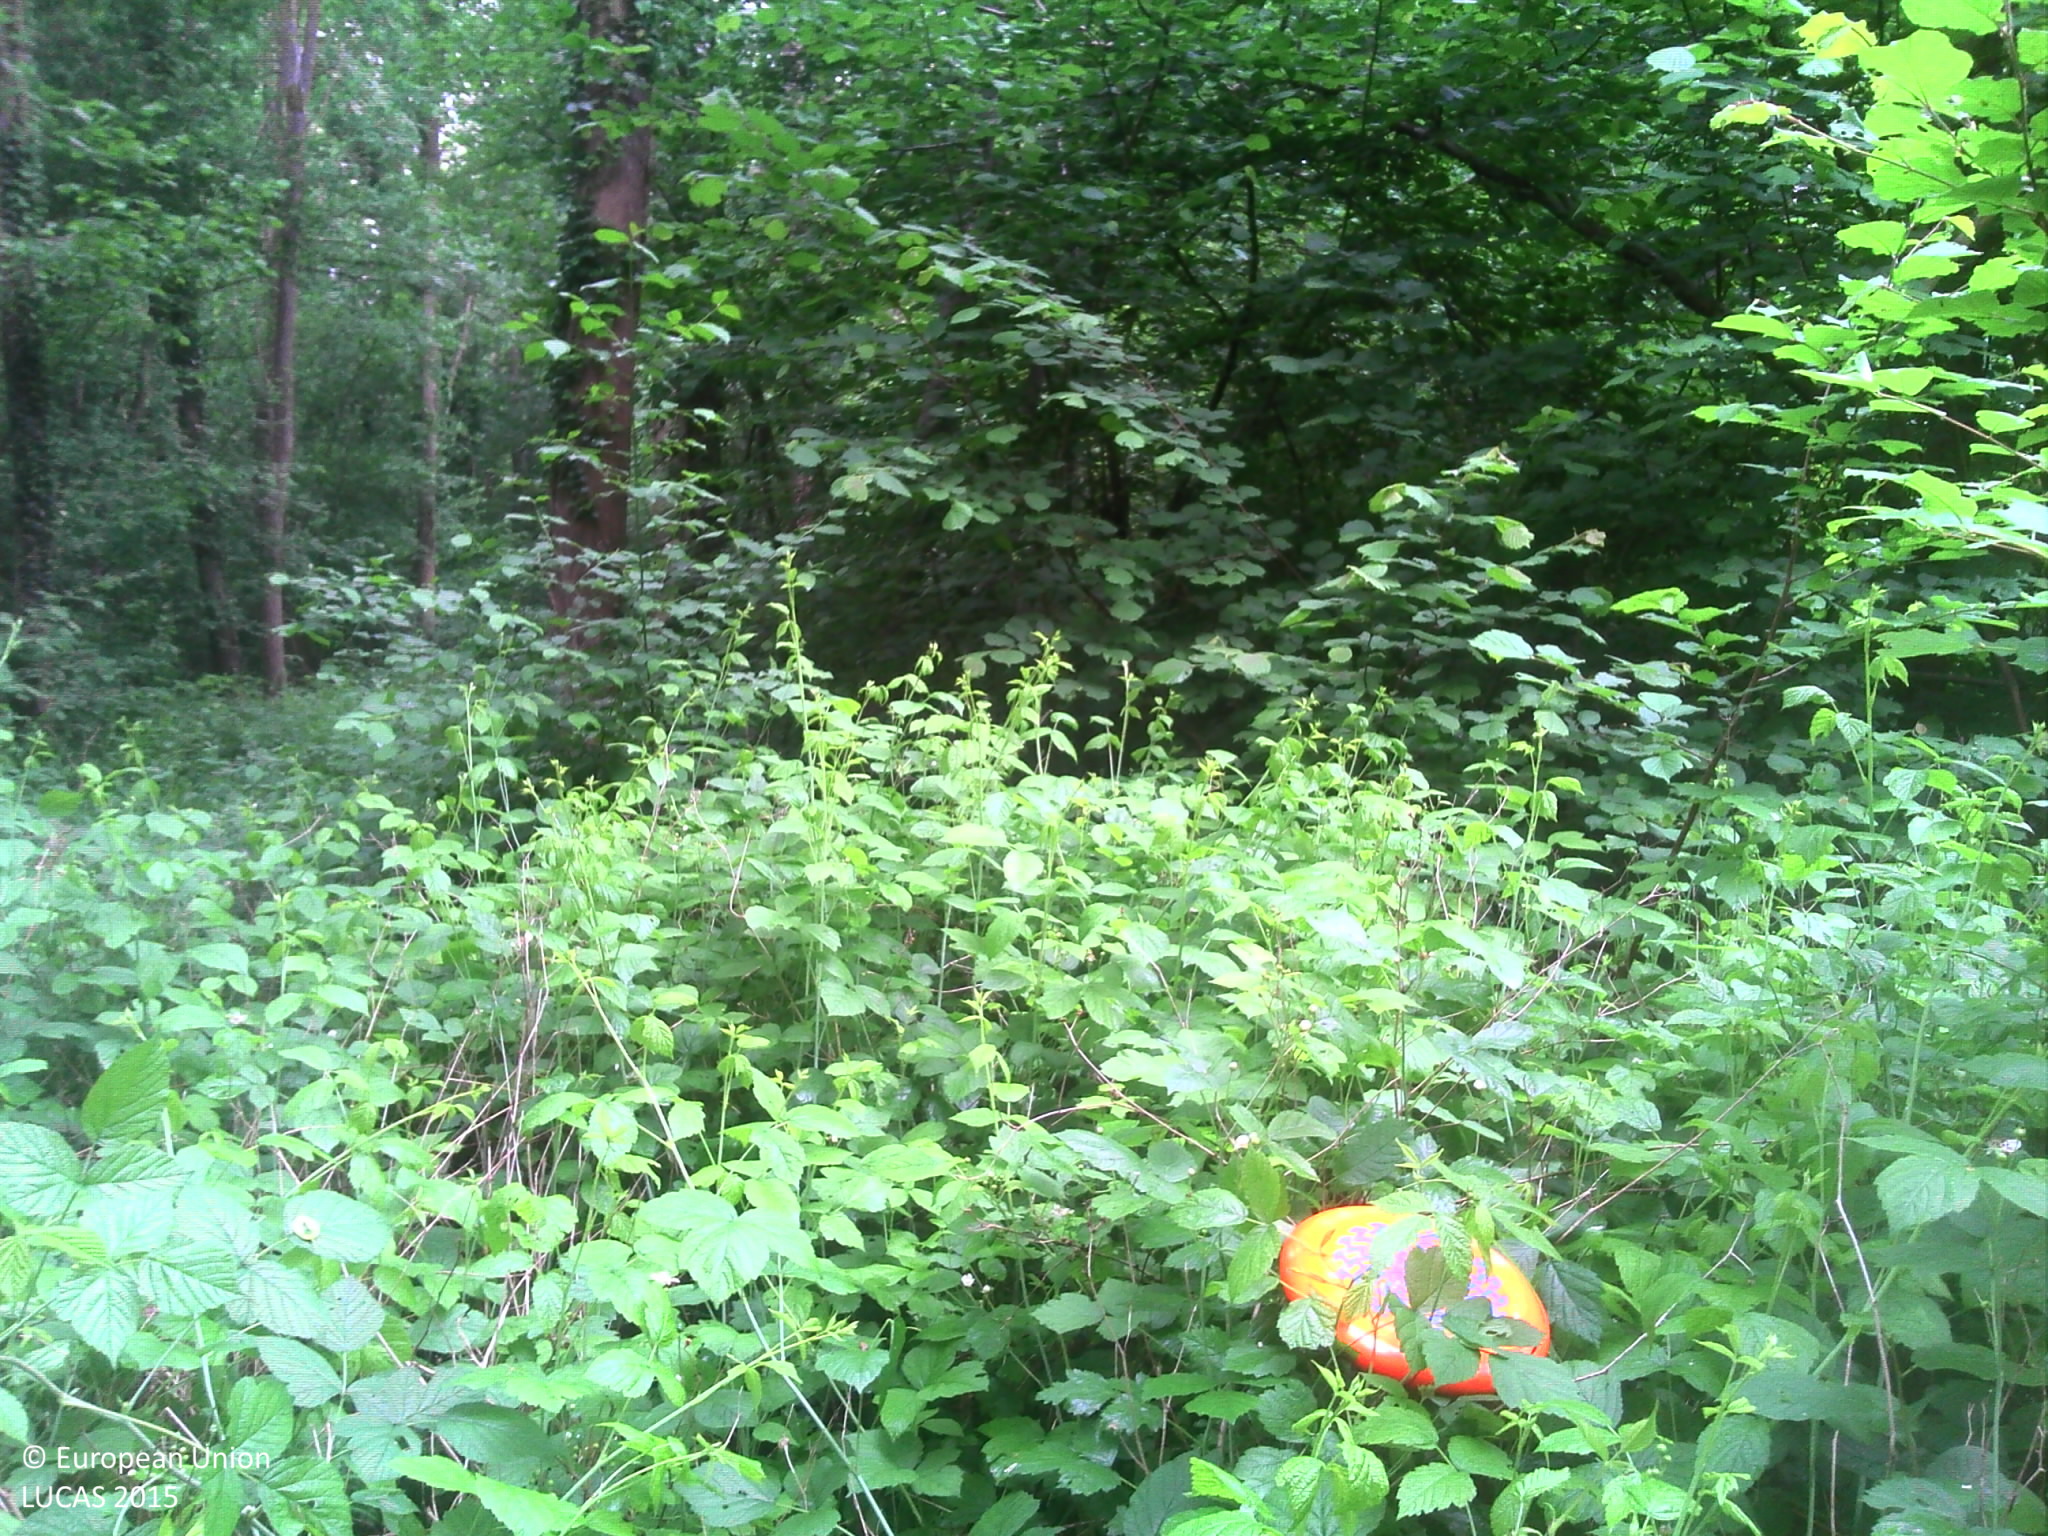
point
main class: Woodland
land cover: Broadleaved woodland
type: mesophytic deciduous forest
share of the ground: > 75 %
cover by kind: broadleaved forest trees 90 %, herbaceous plants 10 %
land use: Forestry
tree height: > 5 m
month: May
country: FR
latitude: 48.2704
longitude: 7.6432
